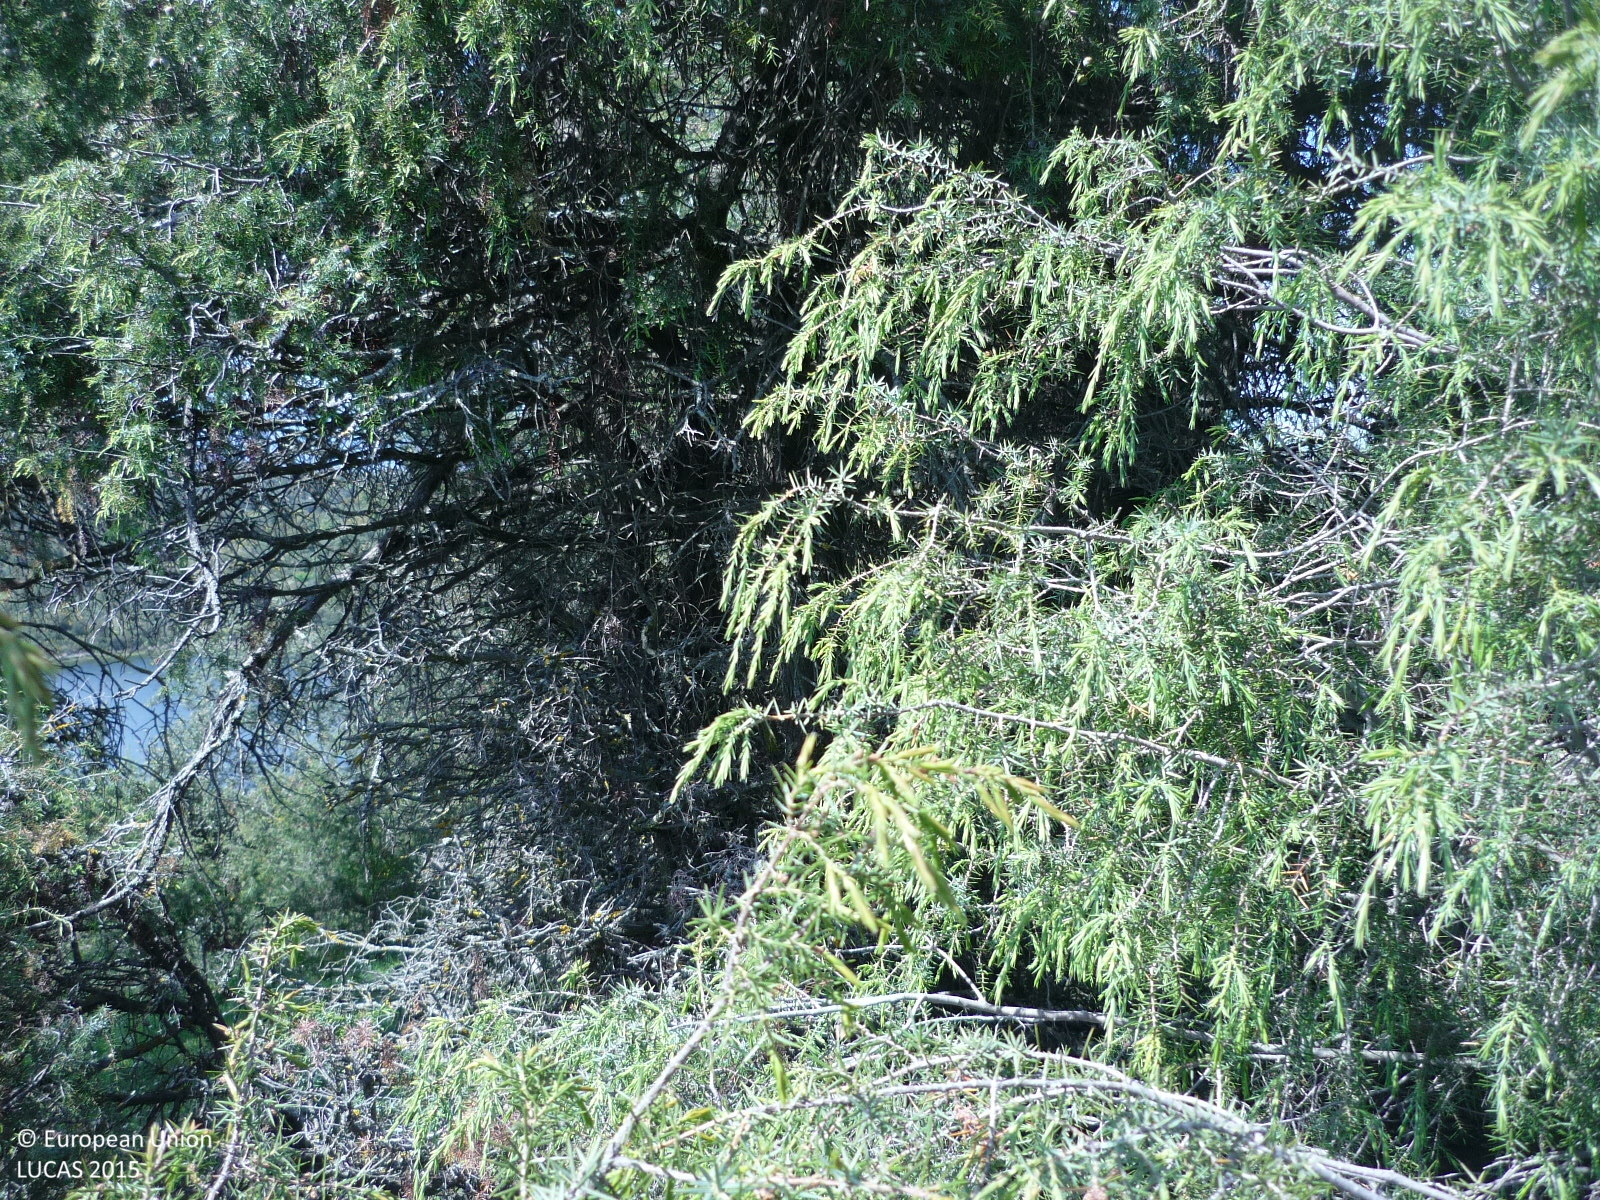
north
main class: Woodland
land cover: Spruce dominated coniferous woodland
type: coniferous forest of the mediterranean region
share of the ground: > 75 %
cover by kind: coniferous forest trees 75 %, shrubs 15 %, herbaceous plants 10 %
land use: Semi-natural and natural areas not in use
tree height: < 5 m
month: April
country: ES
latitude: 40.7584
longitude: -3.6275
